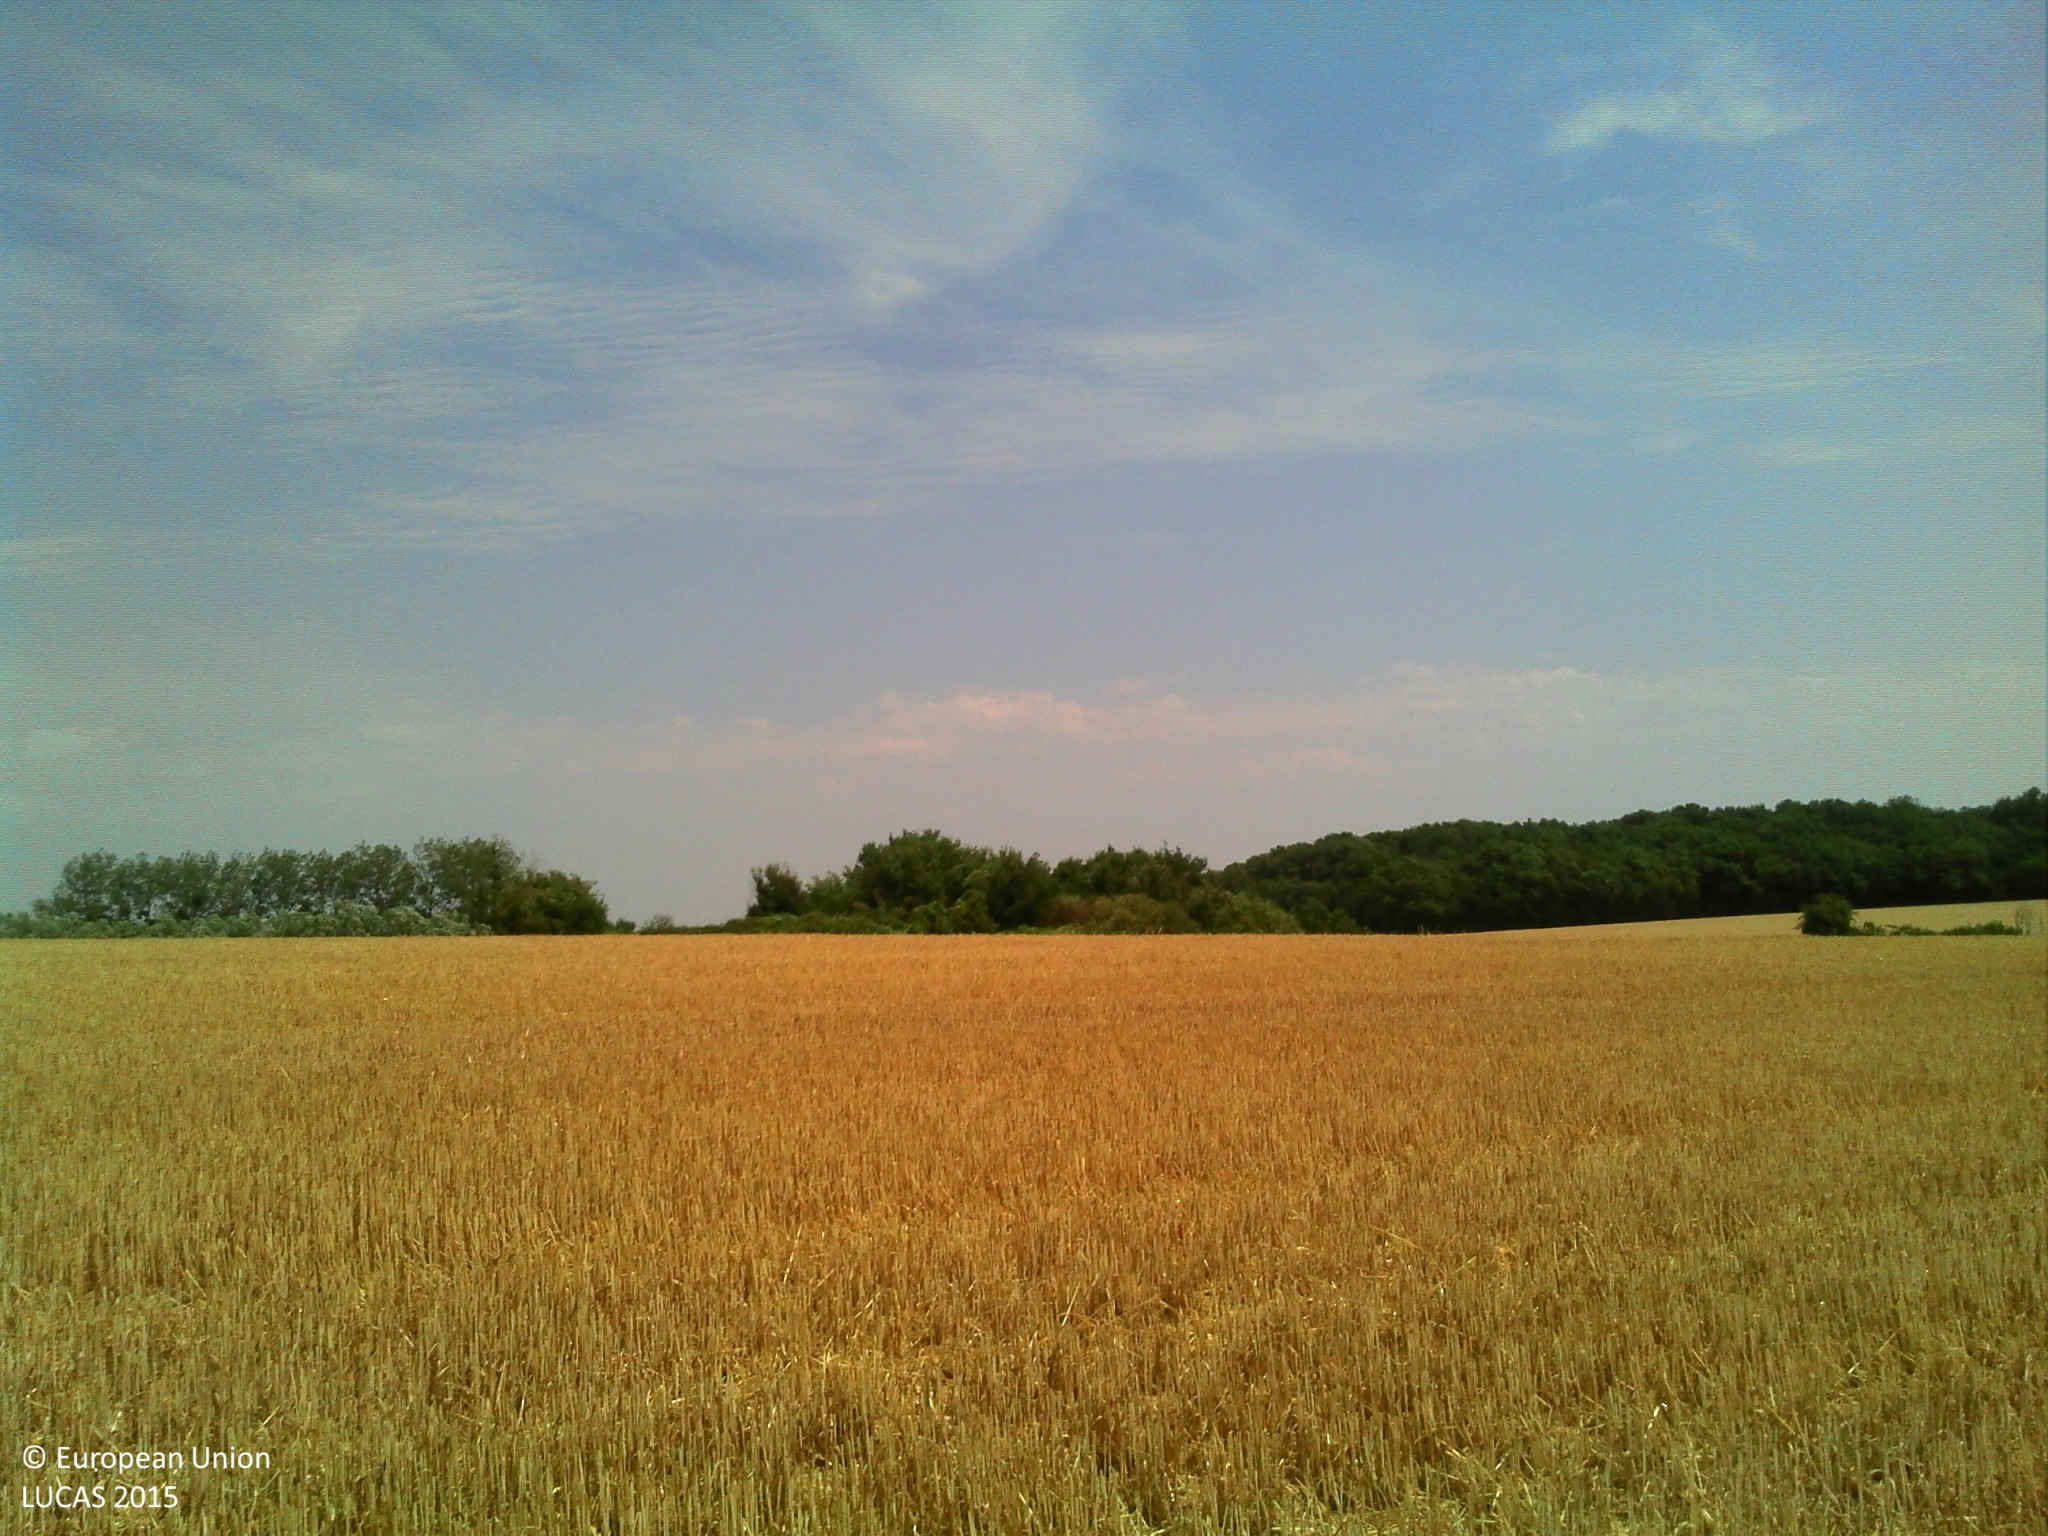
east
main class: Cropland
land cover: Barley
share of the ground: > 75 %
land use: Agriculture (excluding fallow land and kitchen gardens)
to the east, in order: Barley; Shrubland with sparse tree cover; Barley; Tracks; Spontaneously vegetated surfaces; Abandoned hedges; Ditches and canals; Tracks; Grass margins; Common wheat
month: July
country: FR
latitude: 47.9675
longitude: 3.0416
